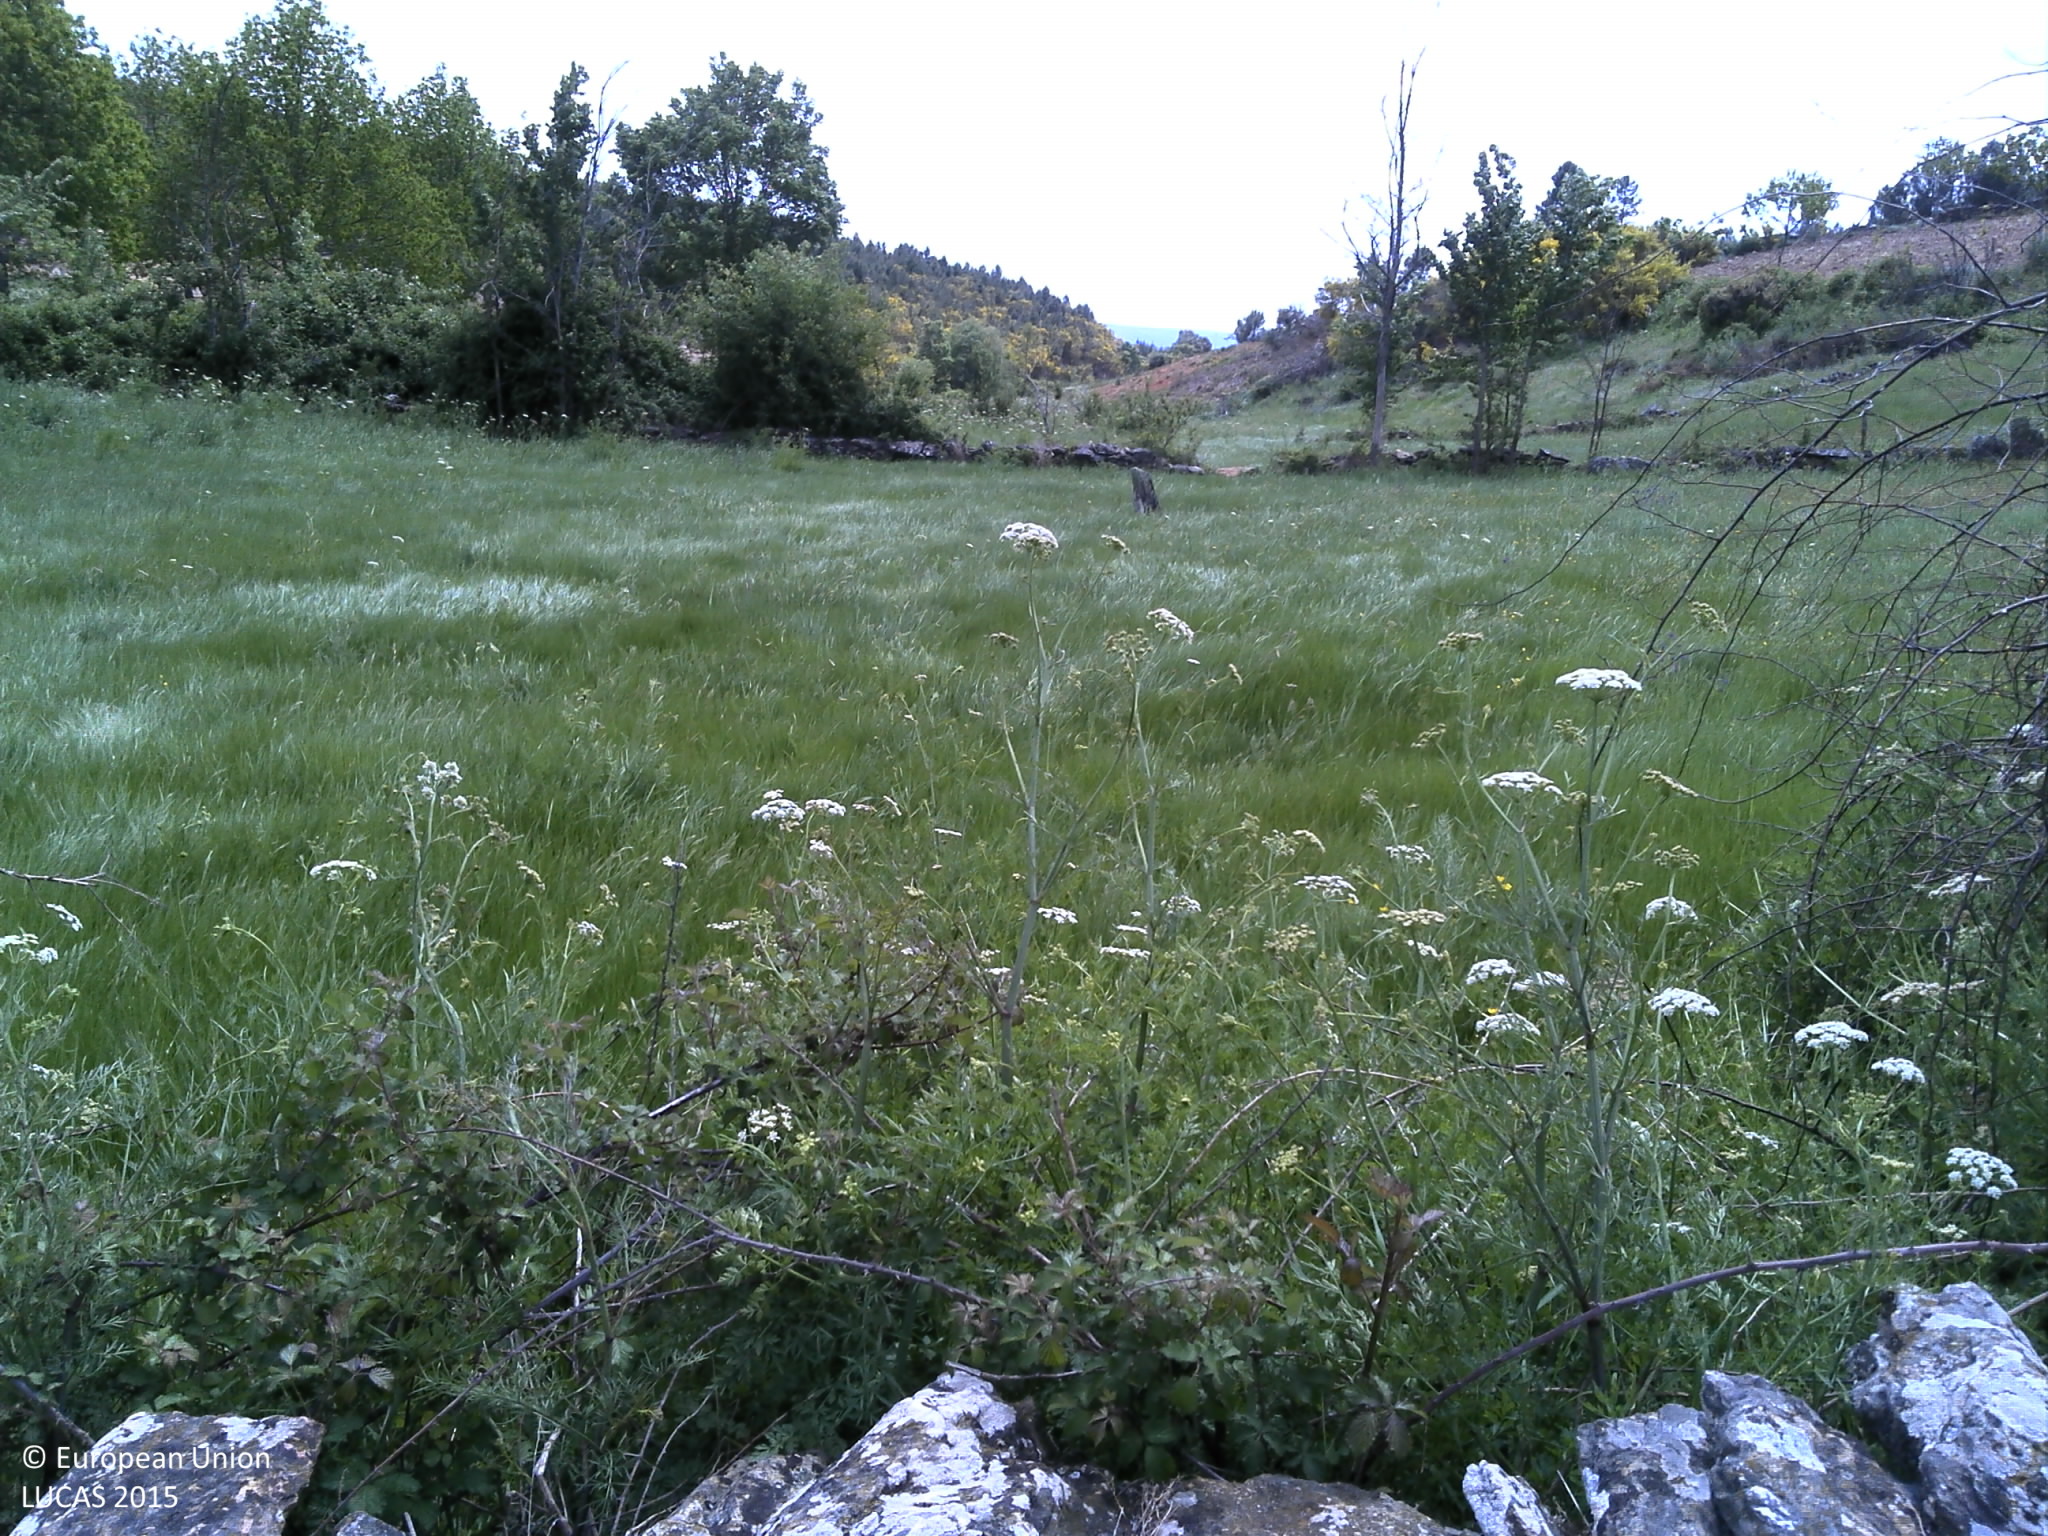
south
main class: Grassland
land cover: Grassland without tree/shrub cover
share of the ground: > 75 %
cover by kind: herbaceous plants 100 %
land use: Agriculture (excluding fallow land and kitchen gardens)
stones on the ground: < 10 %
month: May
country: PT
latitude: 41.5277
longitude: -7.4685
